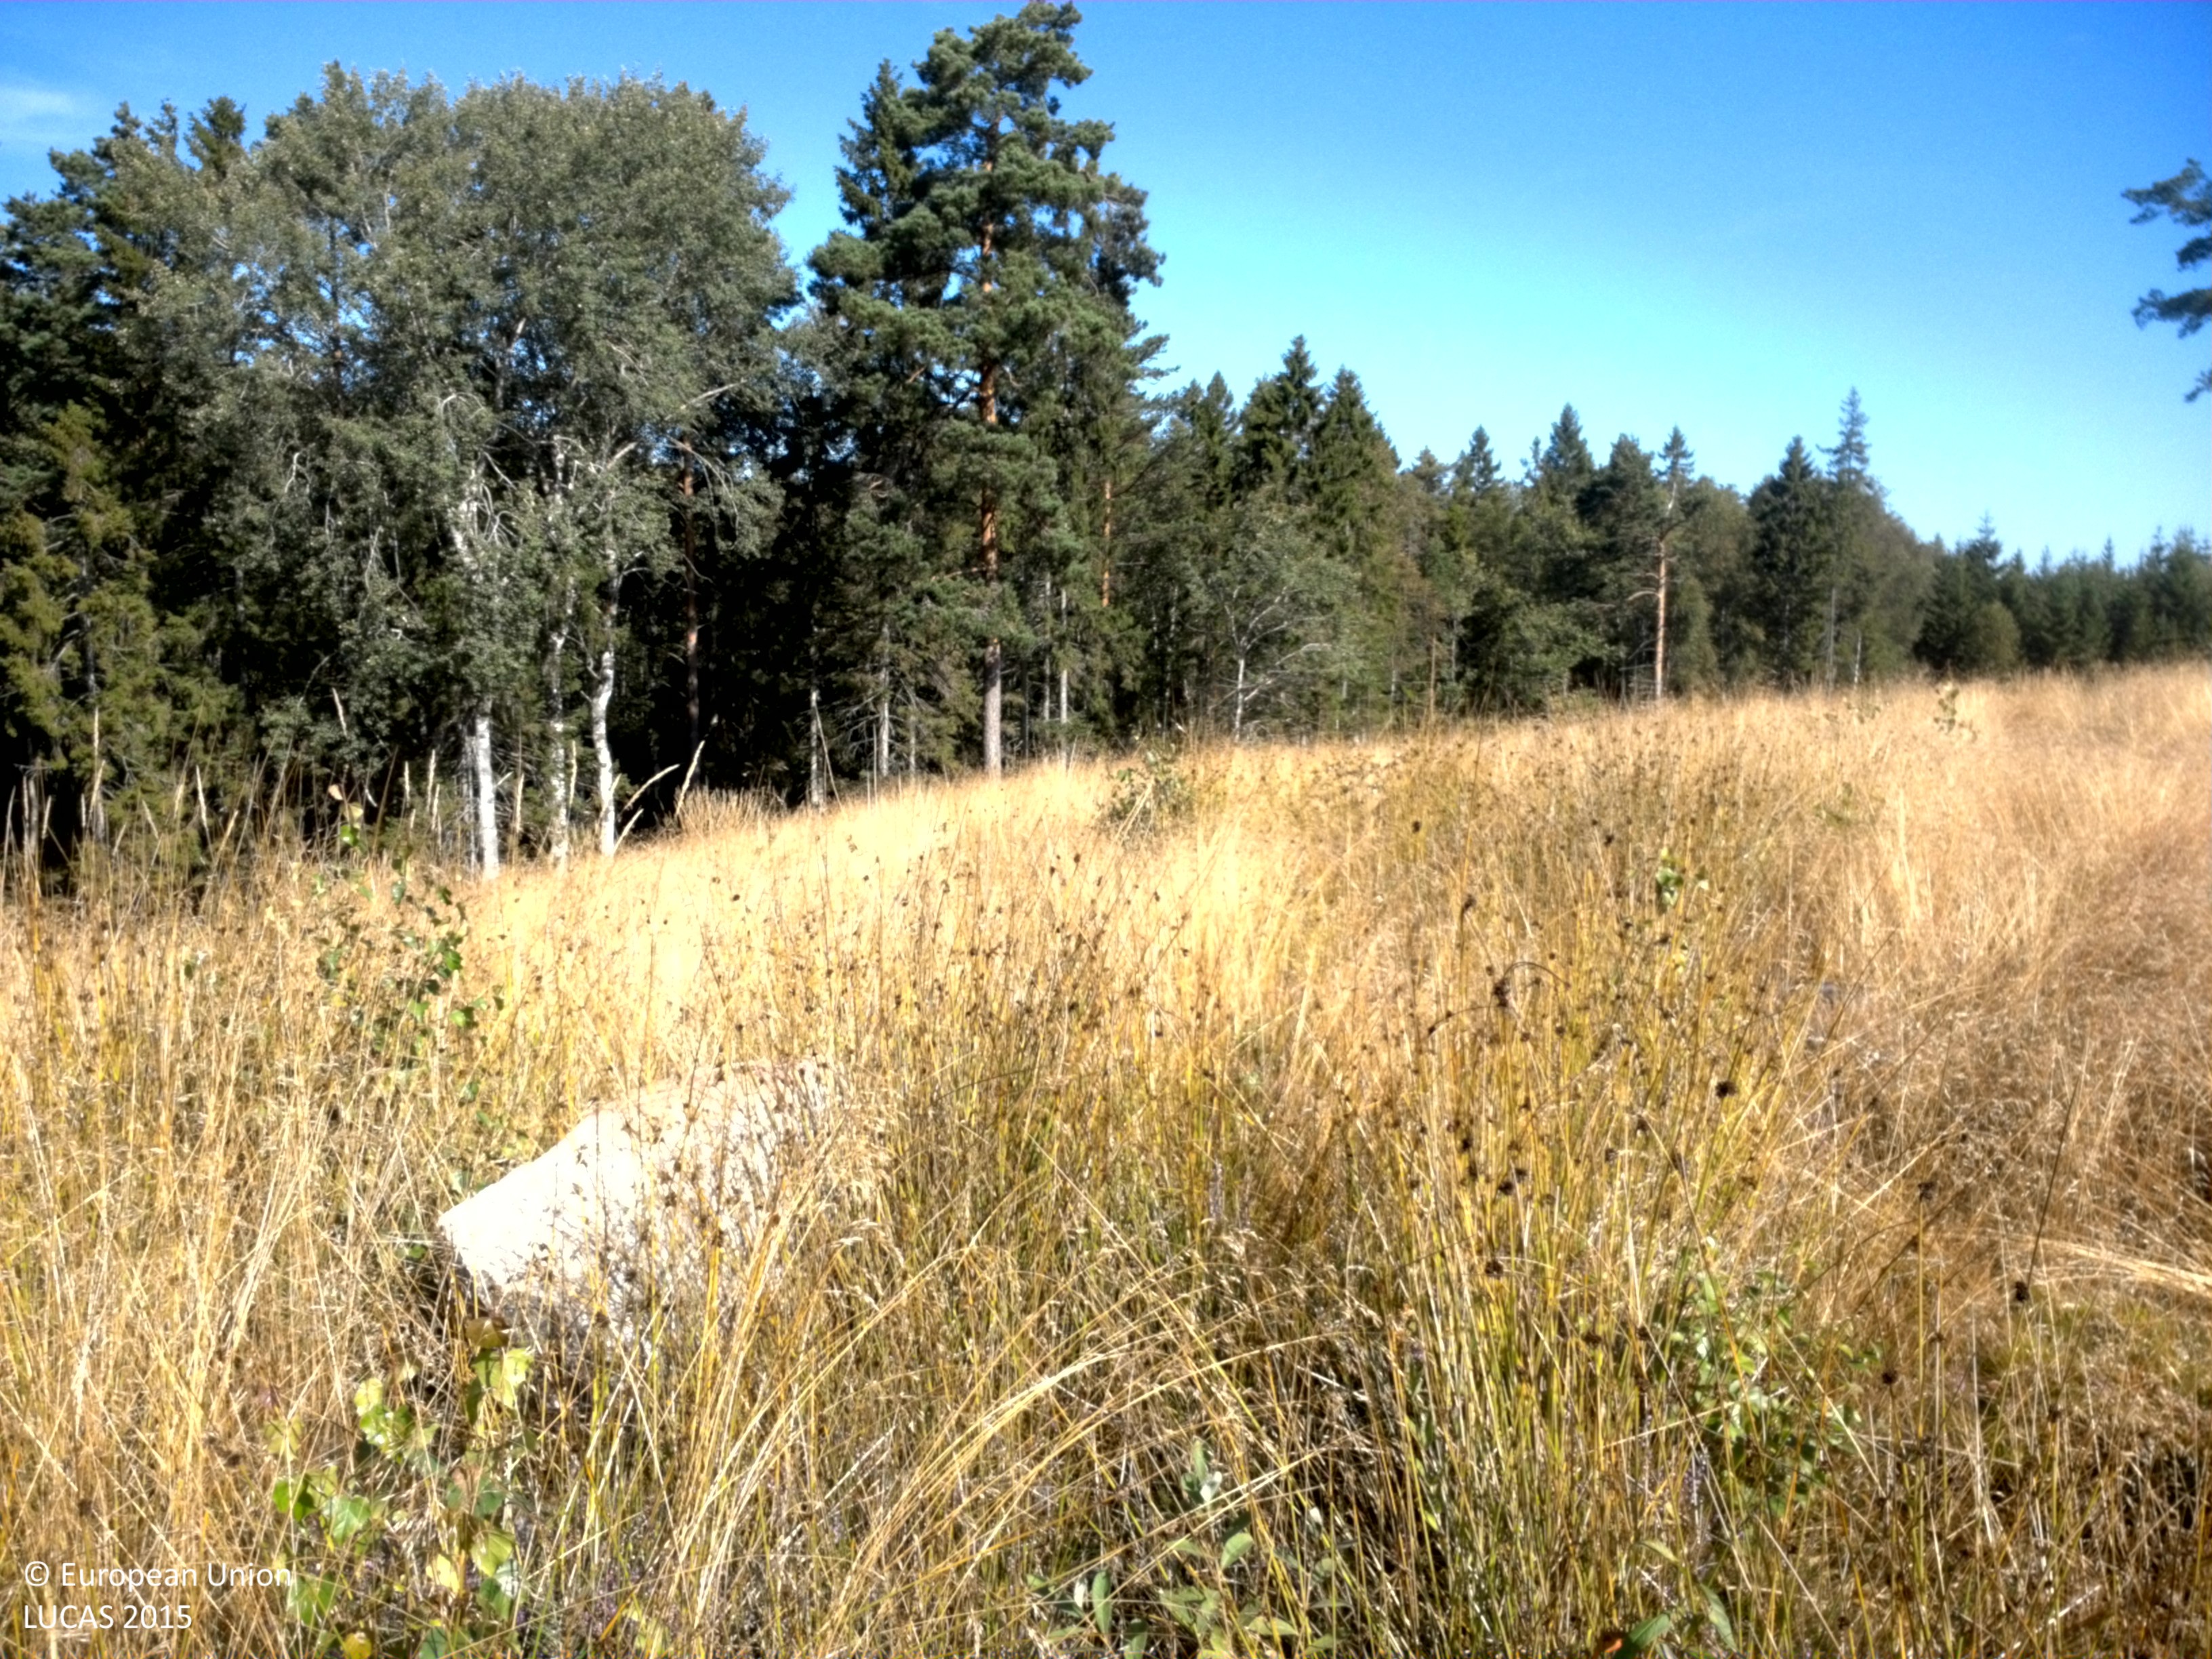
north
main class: Grassland
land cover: Grassland without tree/shrub cover
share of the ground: > 75 %
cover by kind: herbaceous plants 95 %, unconsolidated bare surface 5 %
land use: Forestry
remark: Clear cut
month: August
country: SE
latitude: 59.6079
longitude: 18.6304
